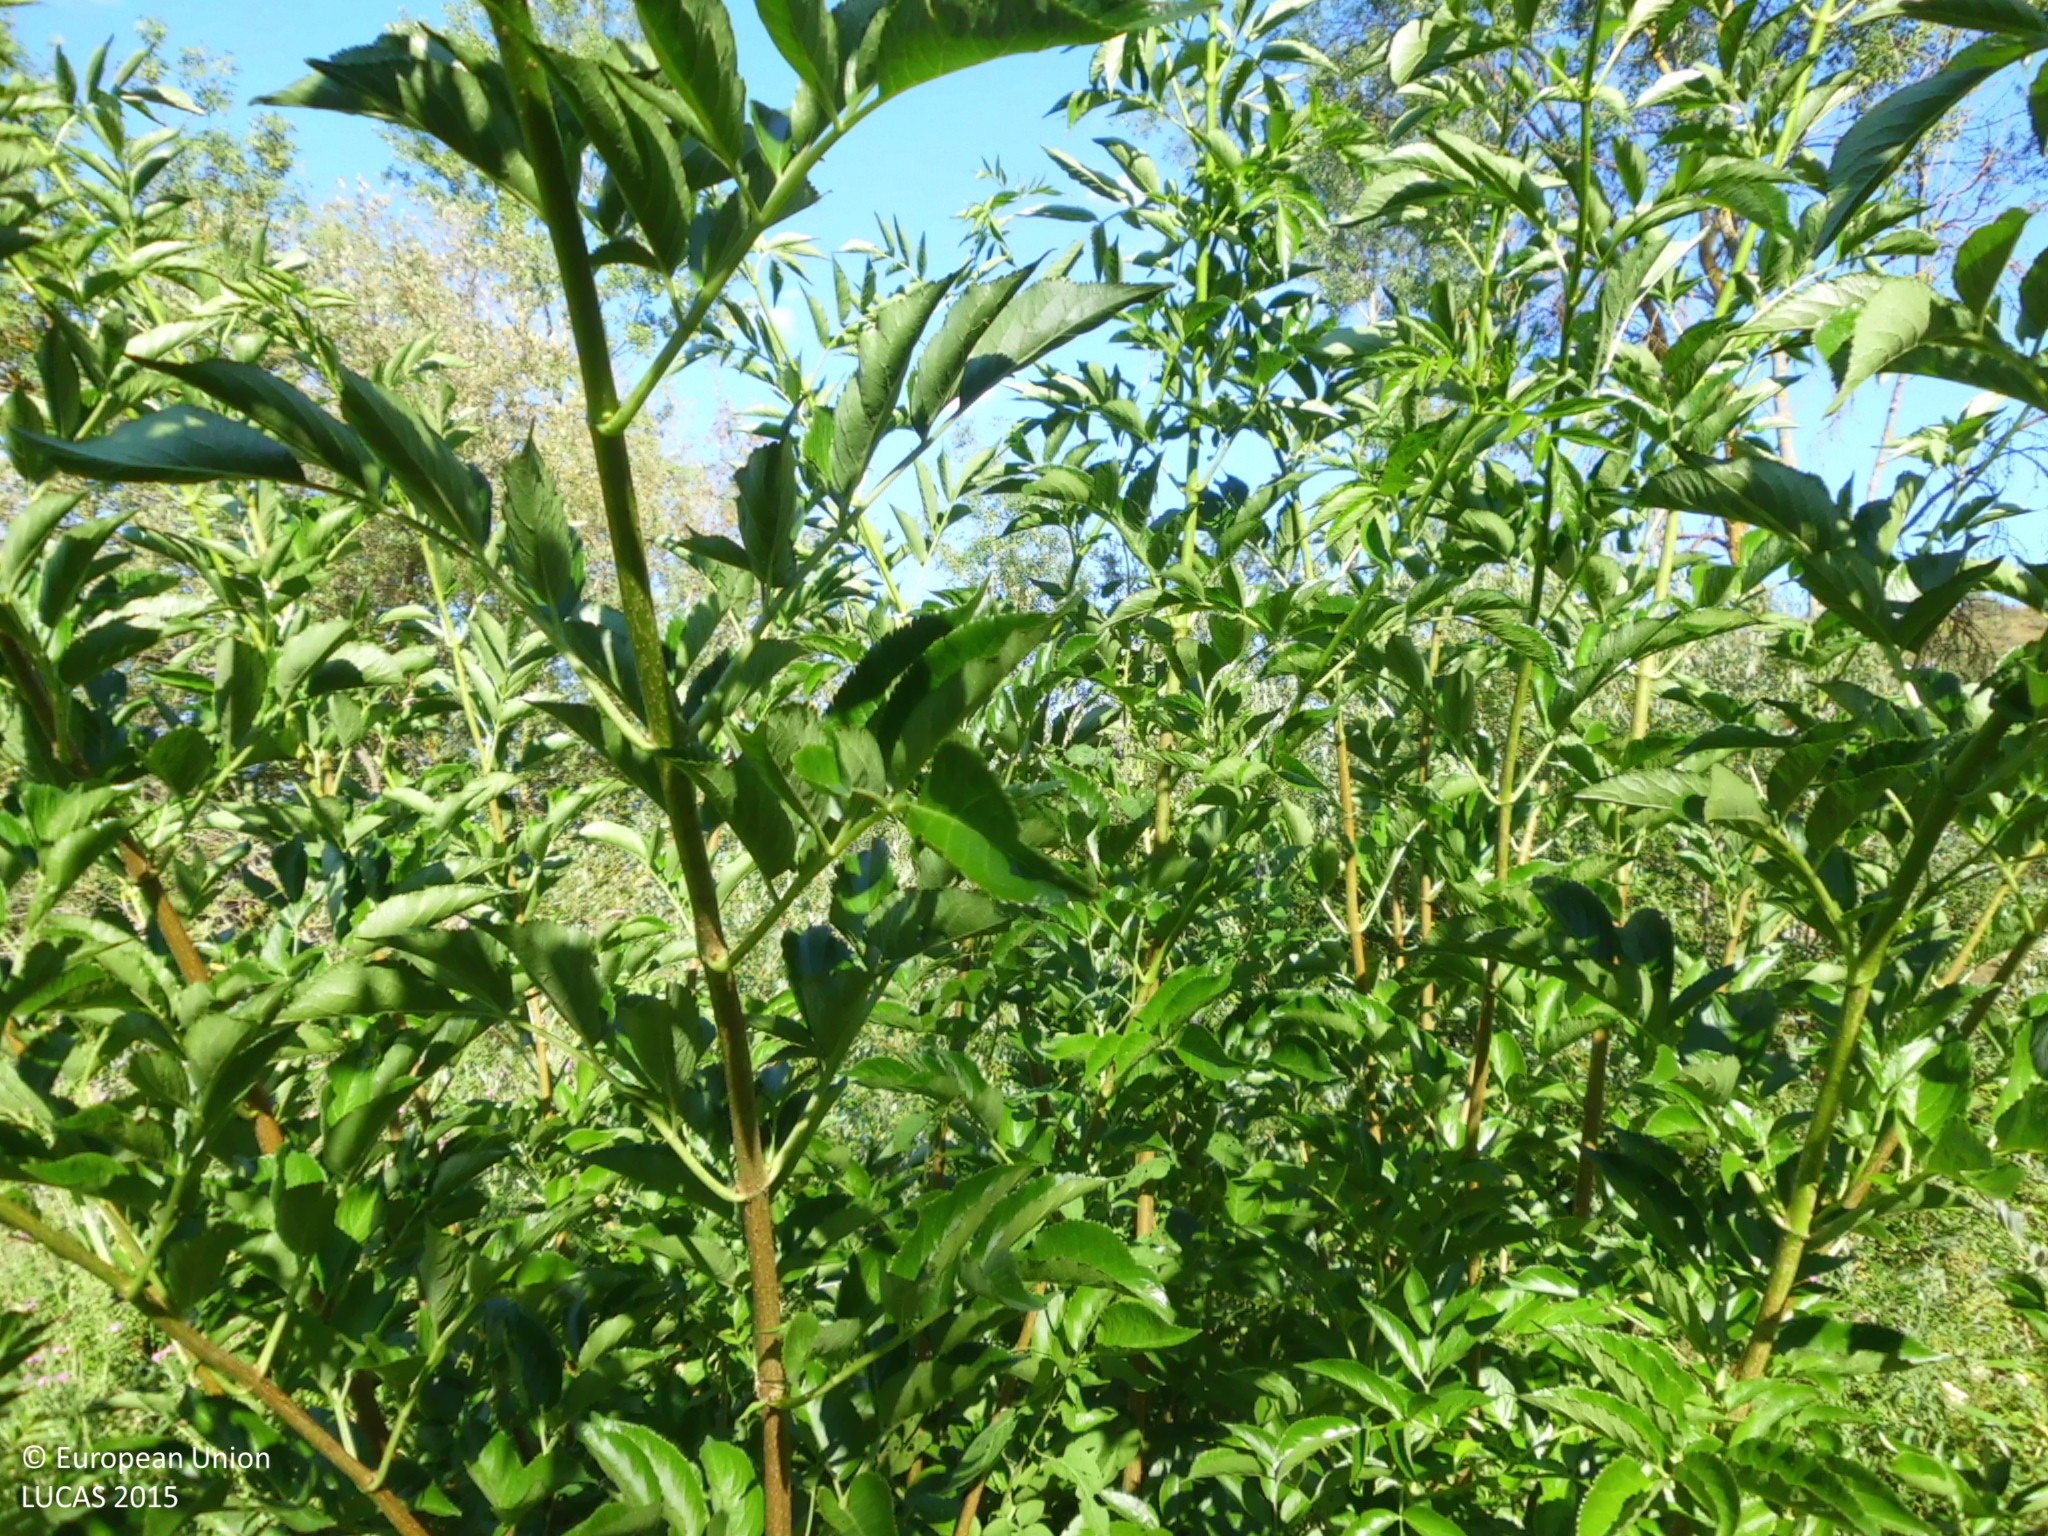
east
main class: Woodland
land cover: Broadleaved woodland
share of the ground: > 75 %
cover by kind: broadleaved forest trees 80 %, shrubs 20 %
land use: Semi-natural and natural areas not in use
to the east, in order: Broadleaved woodland; Inland fresh running water; Broadleaved woodland; Tracks; Grassland without tree/shrub cover; Tracks; Fences; Grassland without tree/shrub cover
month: July
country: ES
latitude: 42.8557
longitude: -4.4585
